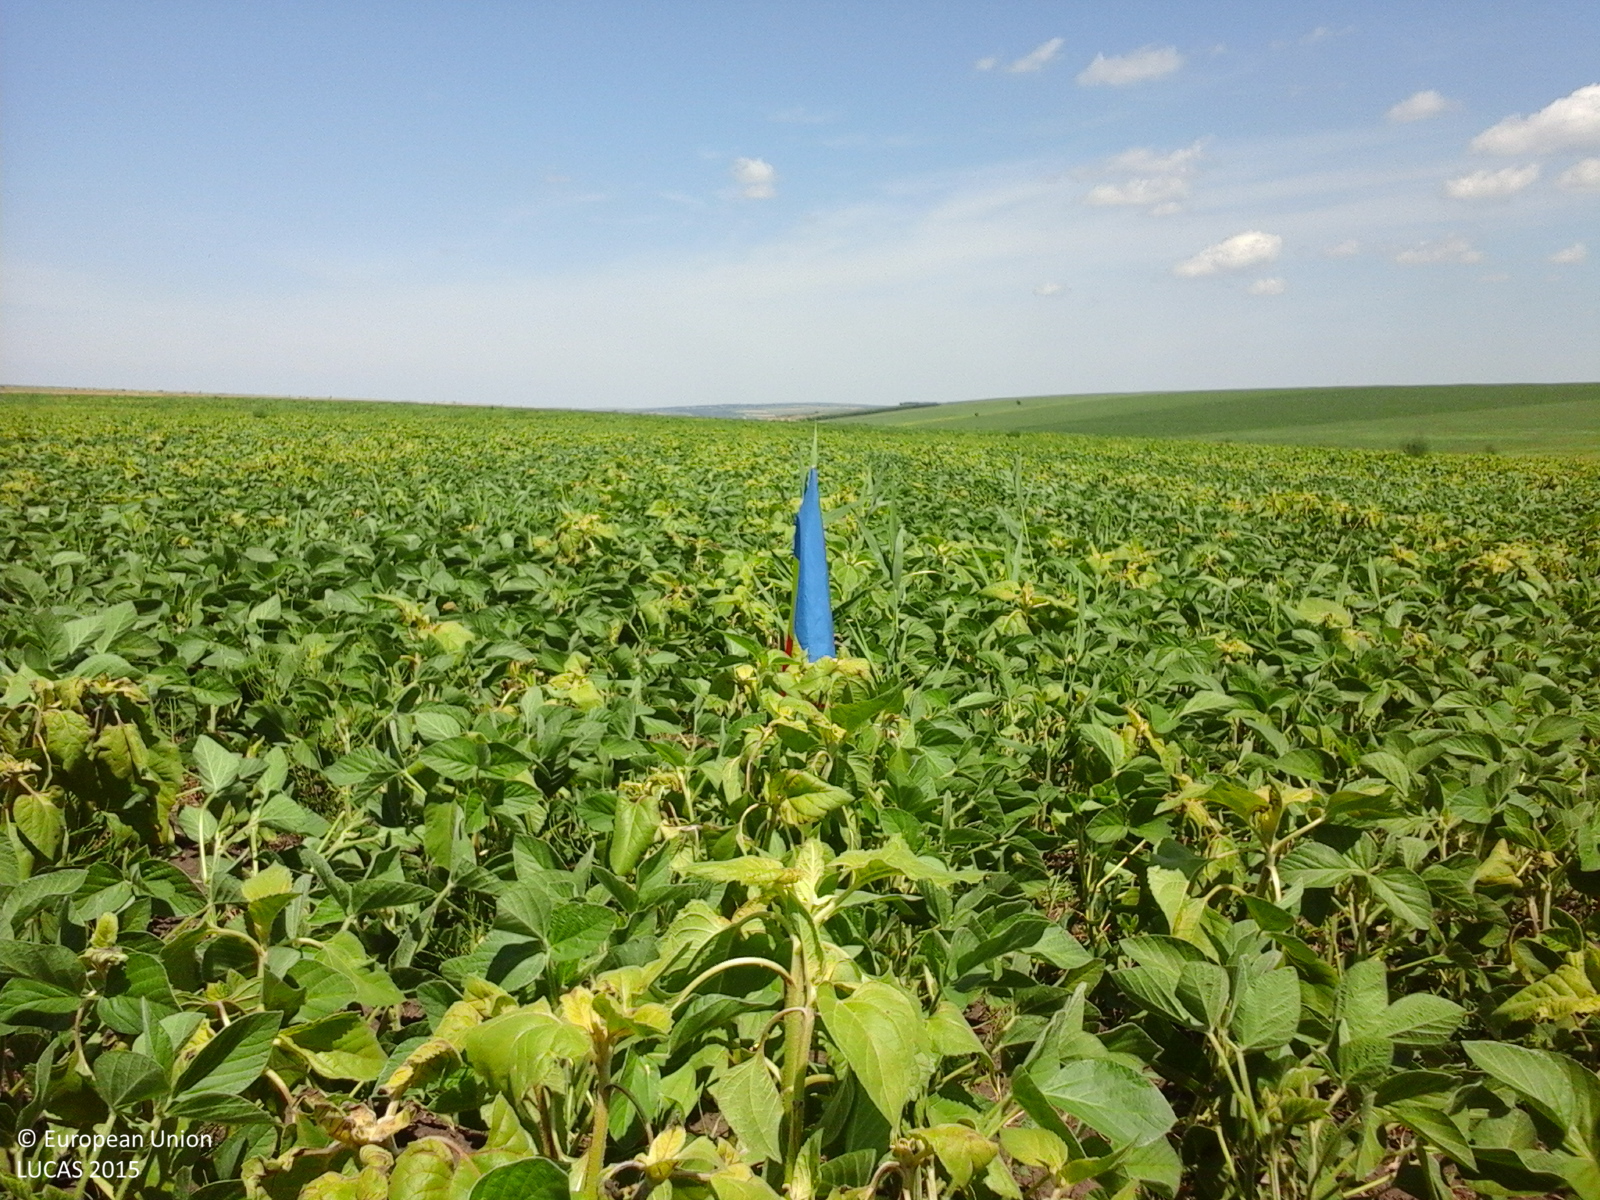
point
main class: Cropland
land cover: Soya
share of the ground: > 75 %
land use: Agriculture (excluding fallow land and kitchen gardens)
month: June
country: RO
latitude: 47.8344
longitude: 26.8408
